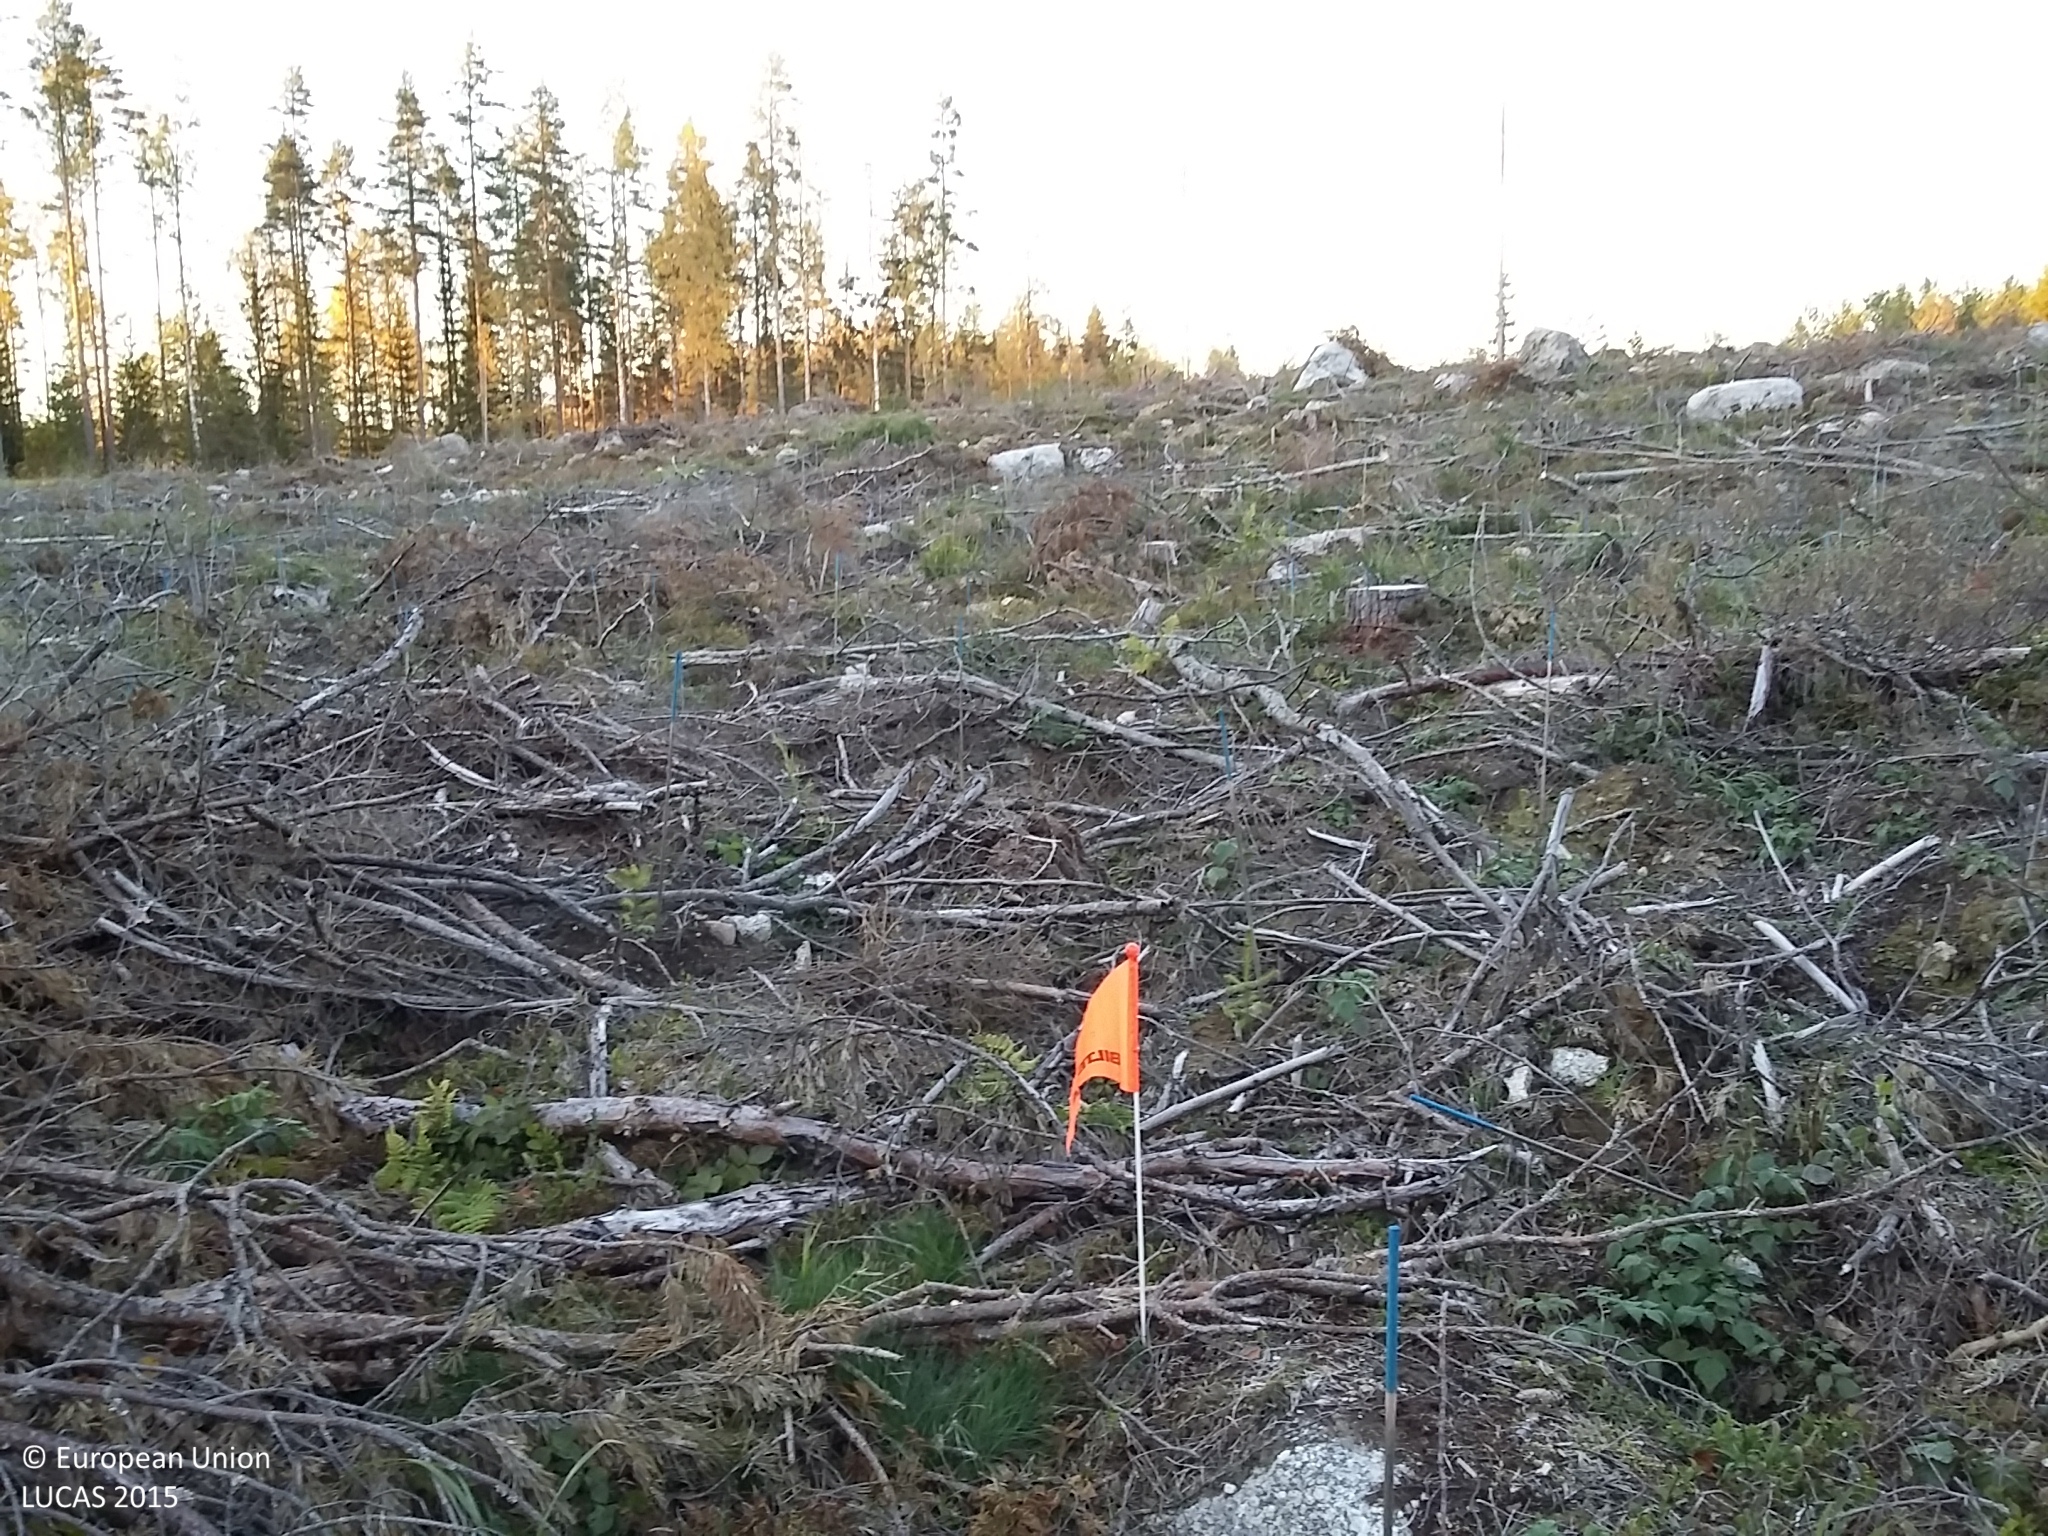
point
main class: Grassland
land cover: Grassland with sparse tree/shrub cover
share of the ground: 10 - 25 %
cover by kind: lichens and mosses 35 %, unconsolidated bare surface 15 %, herbaceous plants 10 %, coniferous forest trees 5 %, shrubs 5 %, consolidated bare surface 5 %
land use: Forestry
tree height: < 5 m
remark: Clear cut
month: October
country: FI
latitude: 62.7154
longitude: 25.9393
